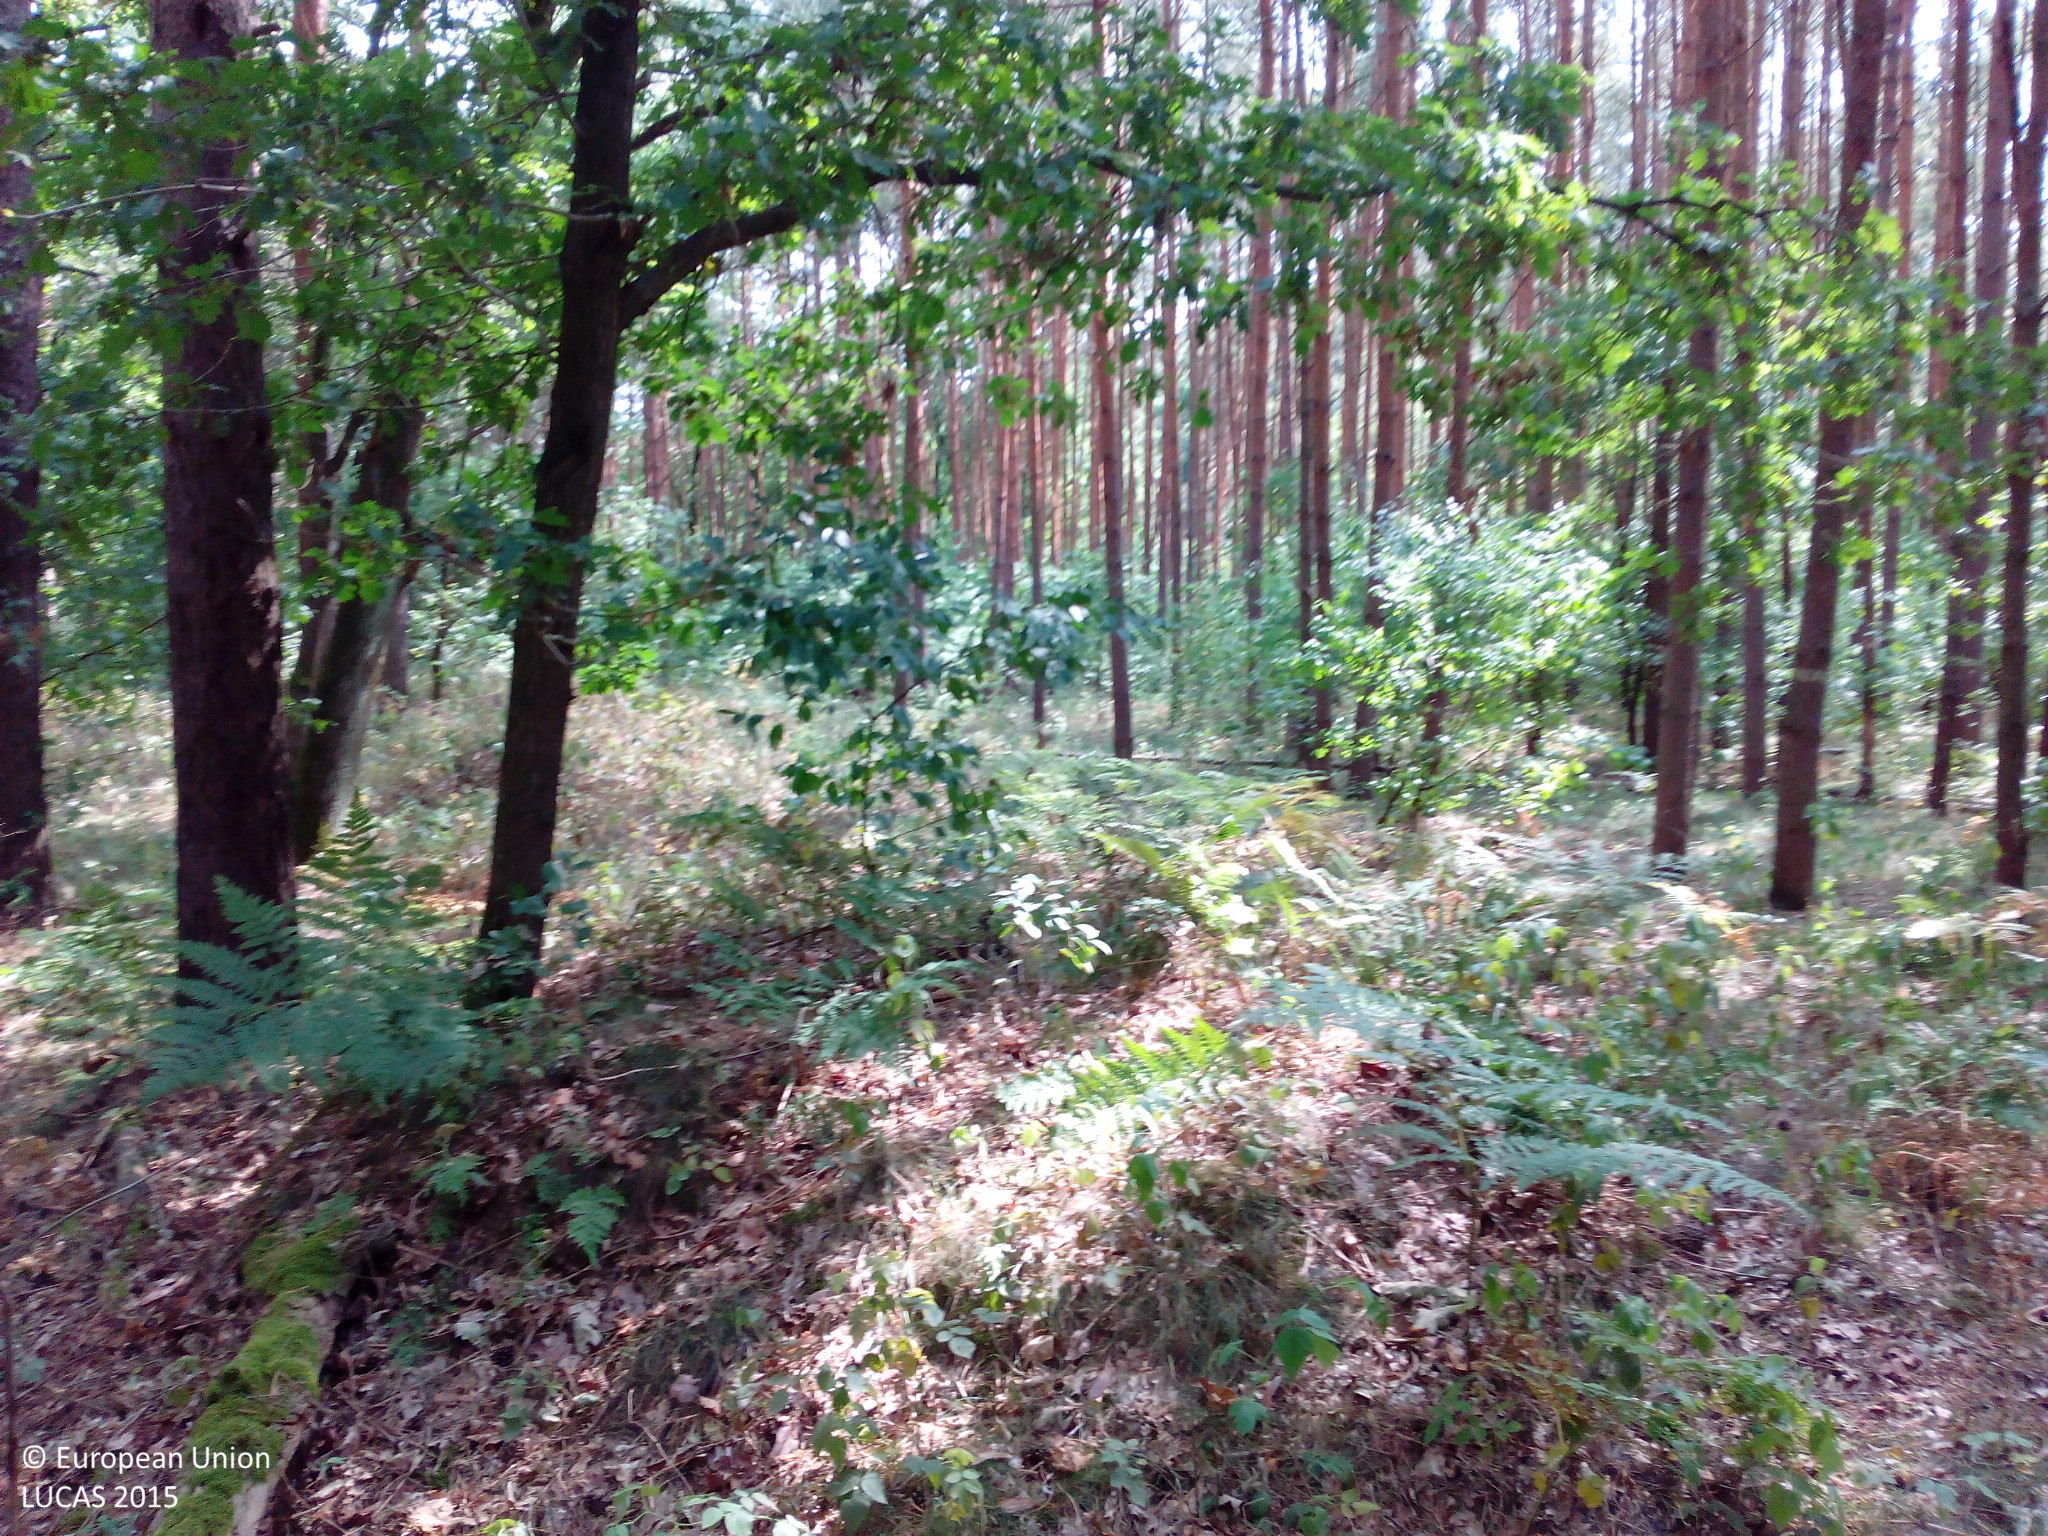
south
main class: Woodland
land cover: Pine dominated coniferous woodland
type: hemiboreal forest and nemoral coniferous forest and mixed broadleaved-coniferous forest
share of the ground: > 75 %
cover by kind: coniferous forest trees 60 %, broadleaved forest trees 20 %, shrubs 10 %, herbaceous plants 5 %, lichens and mosses 5 %
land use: Forestry
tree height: > 5 m
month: August
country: DE
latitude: 52.6408
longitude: 13.1772
